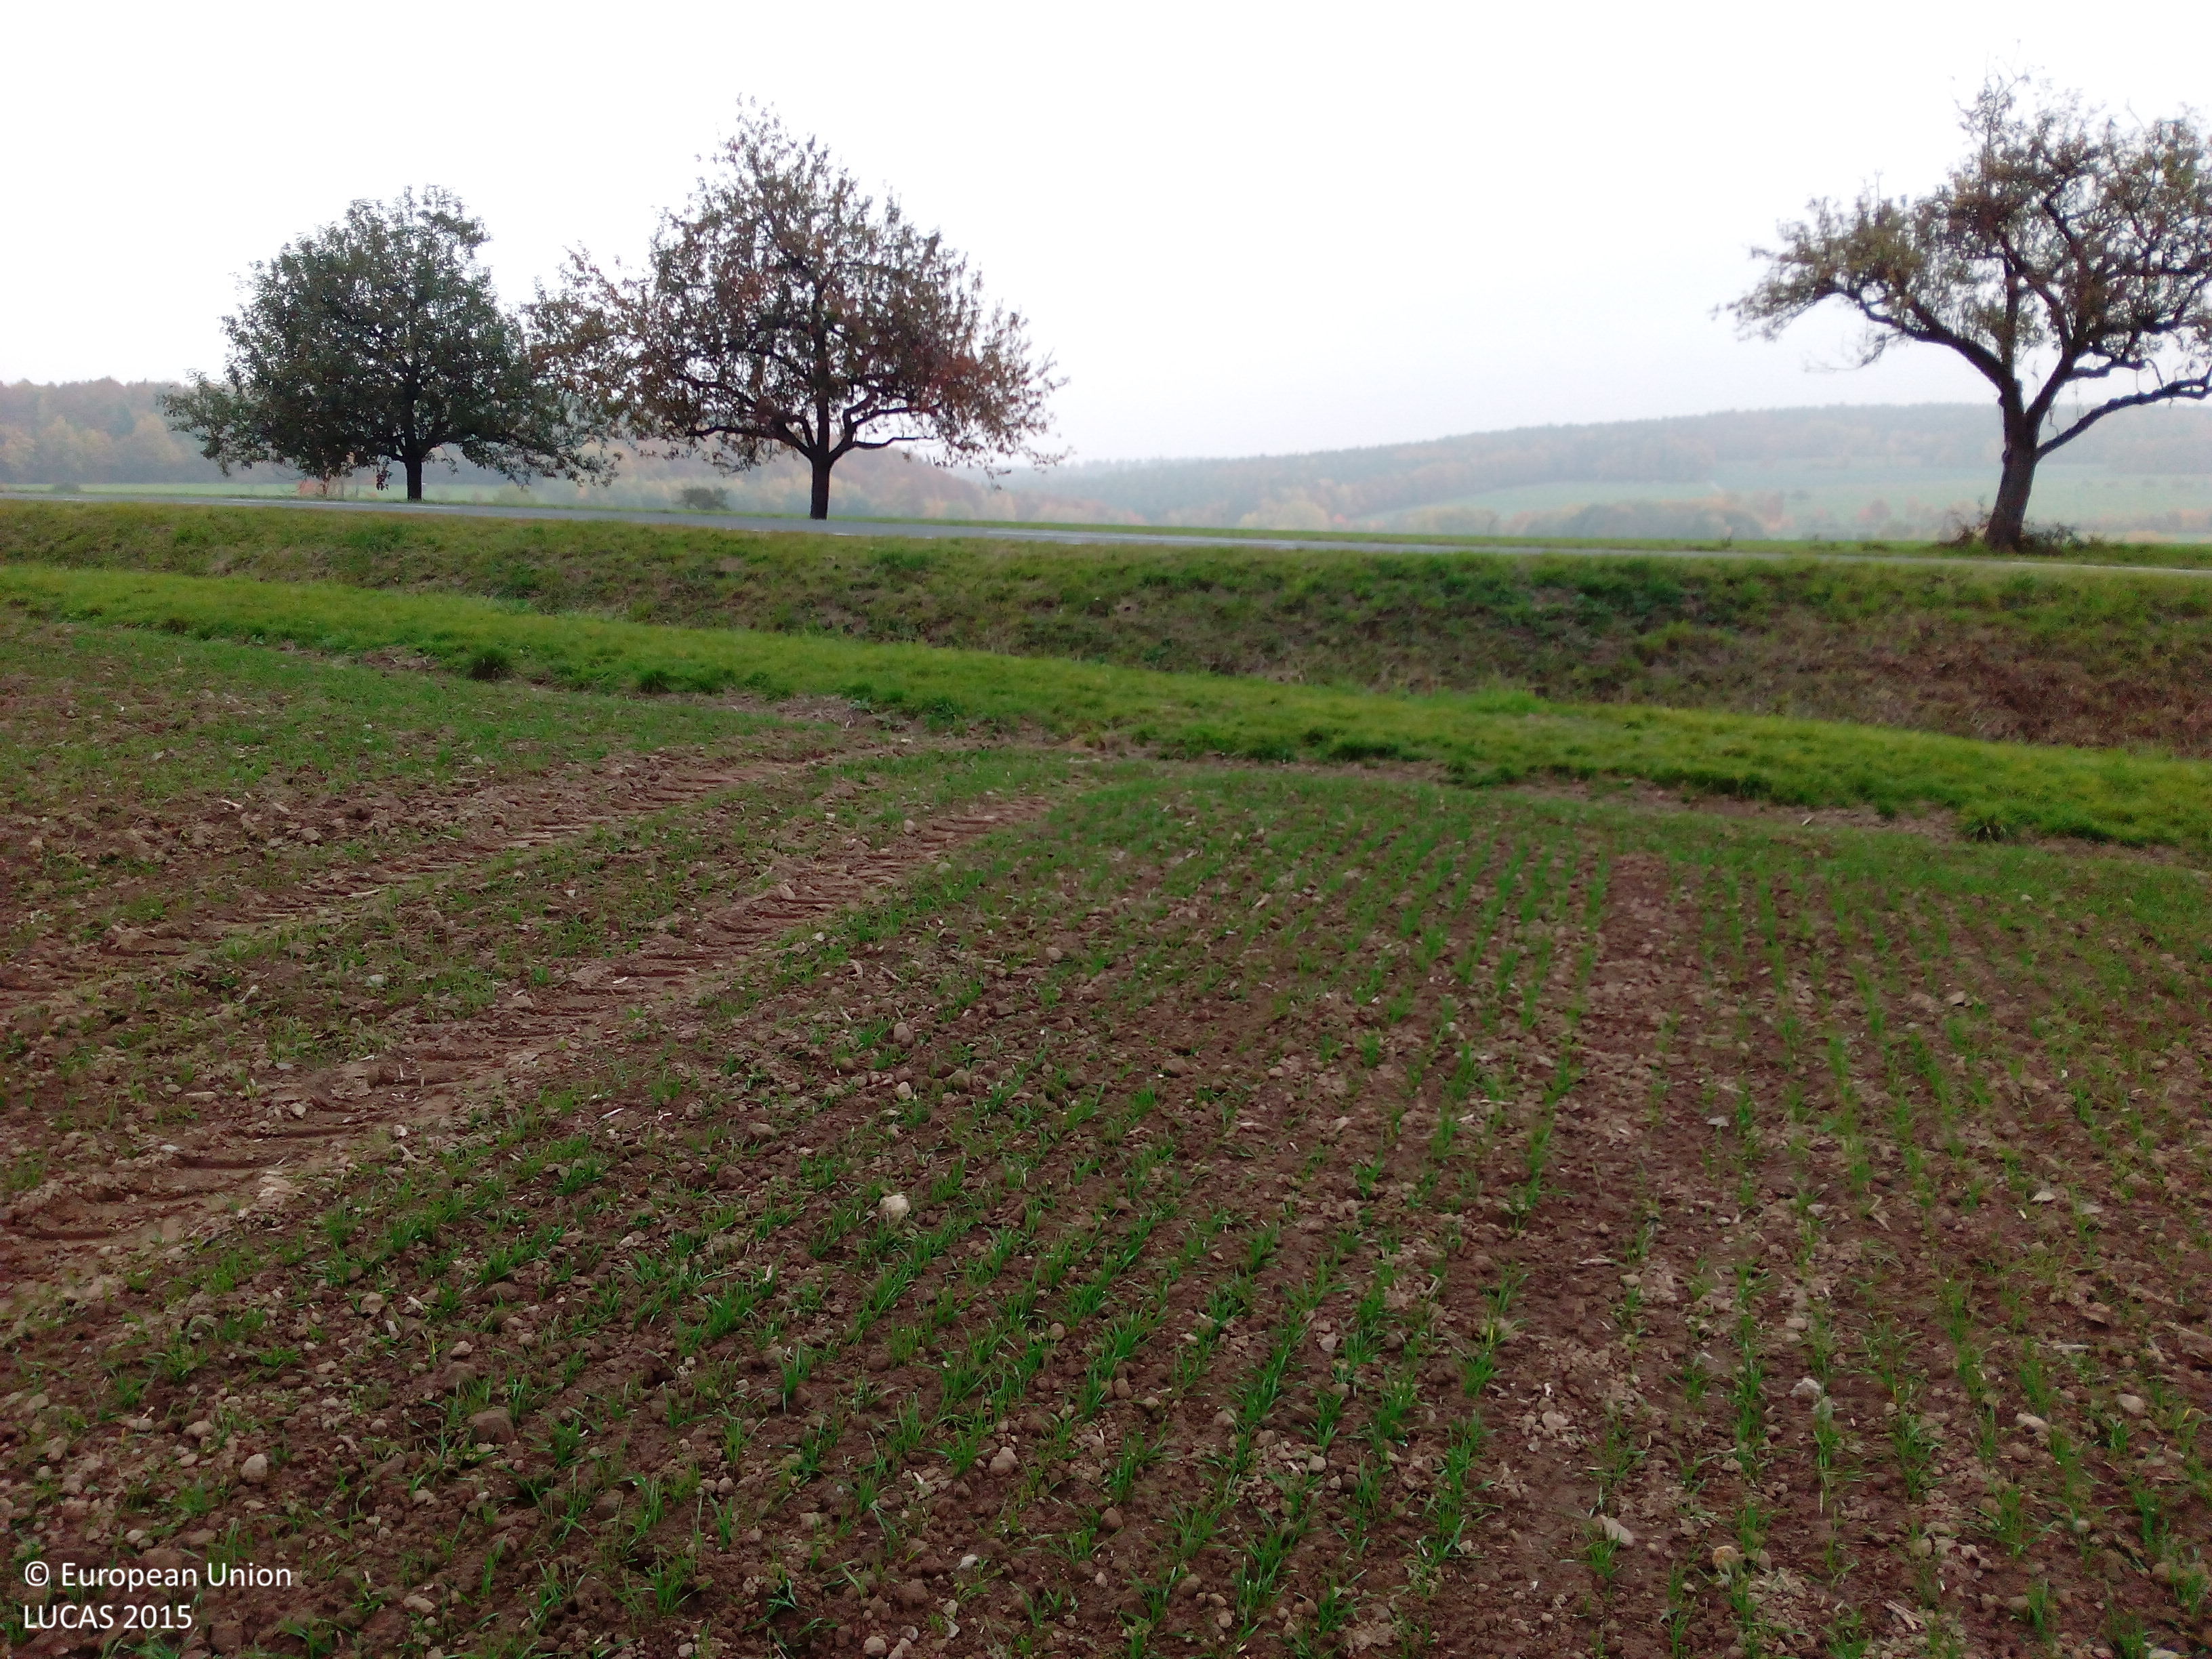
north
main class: Cropland
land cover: Common wheat
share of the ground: < 10 %
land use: Agriculture (excluding fallow land and kitchen gardens)
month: October
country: DE
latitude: 50.2382
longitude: 9.9580
